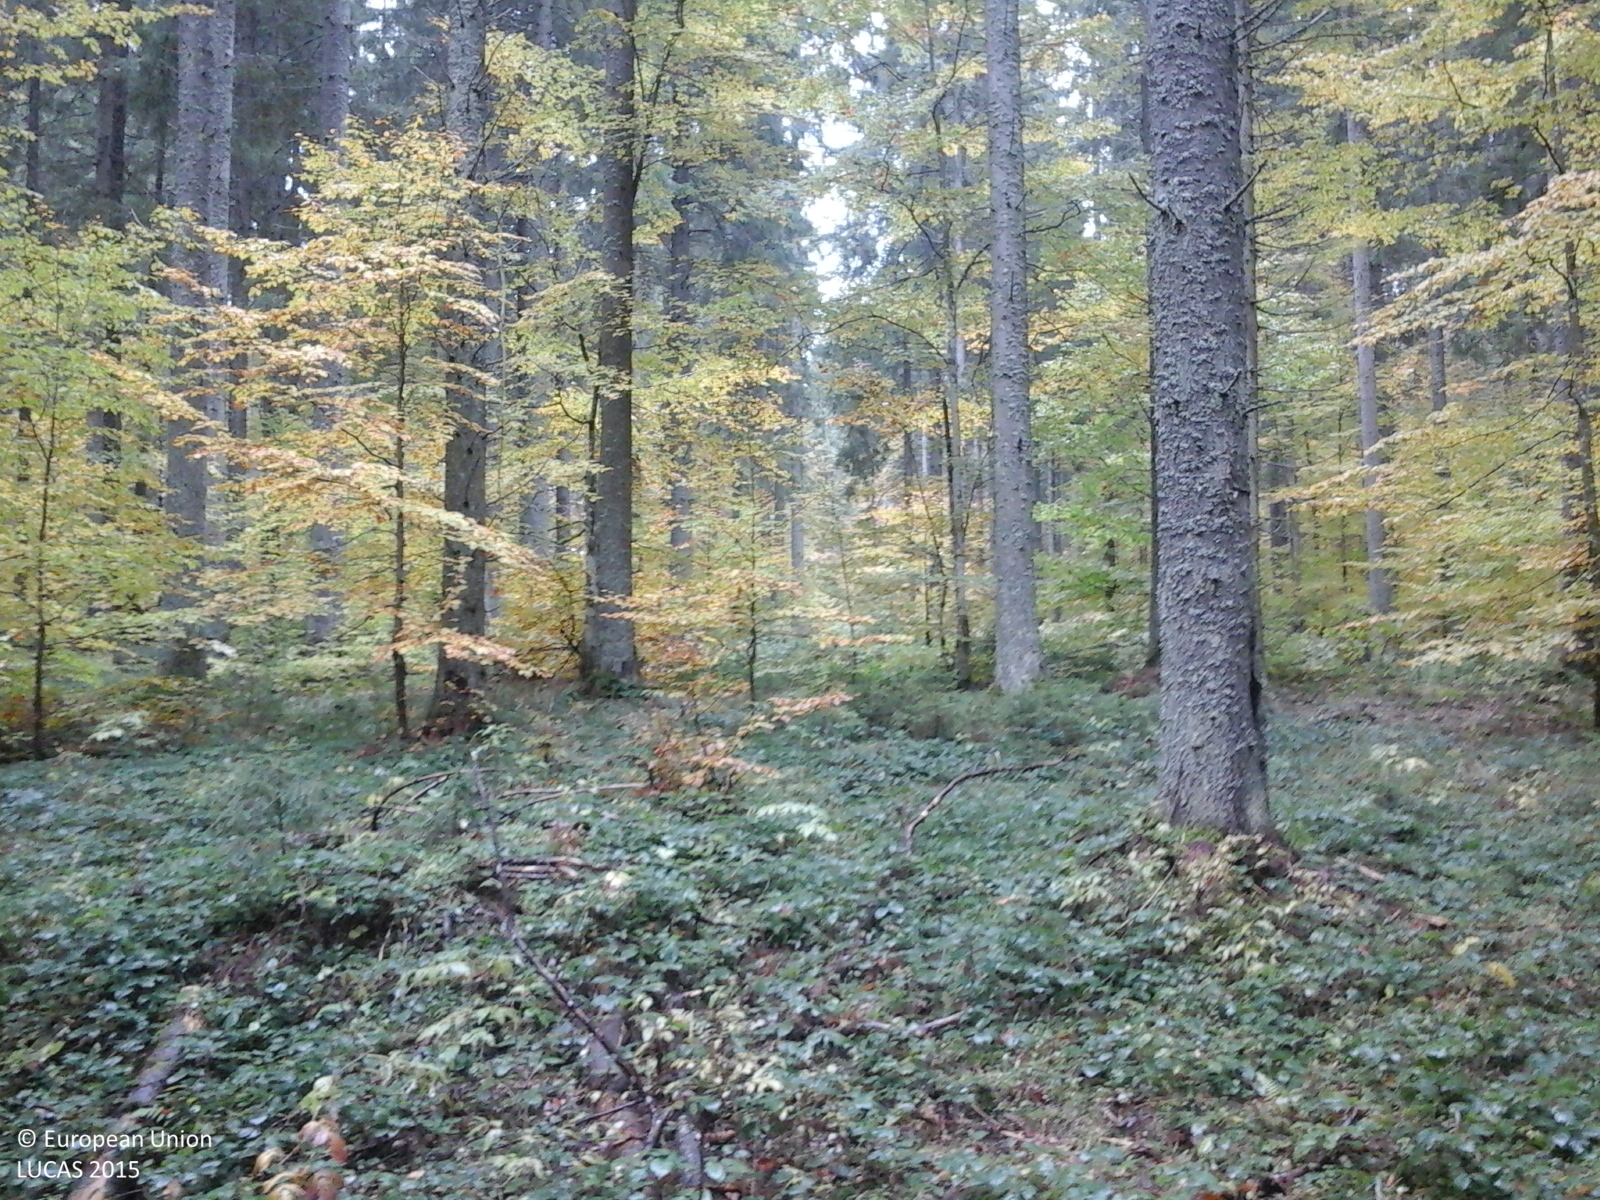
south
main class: Woodland
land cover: Other mixed woodland
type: alpine coniferous forest
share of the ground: > 75 %
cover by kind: coniferous forest trees 70 %, broadleaved forest trees 30 %
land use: Forestry
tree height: > 5 m
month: October
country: RO
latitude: 46.7690
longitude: 25.2559
